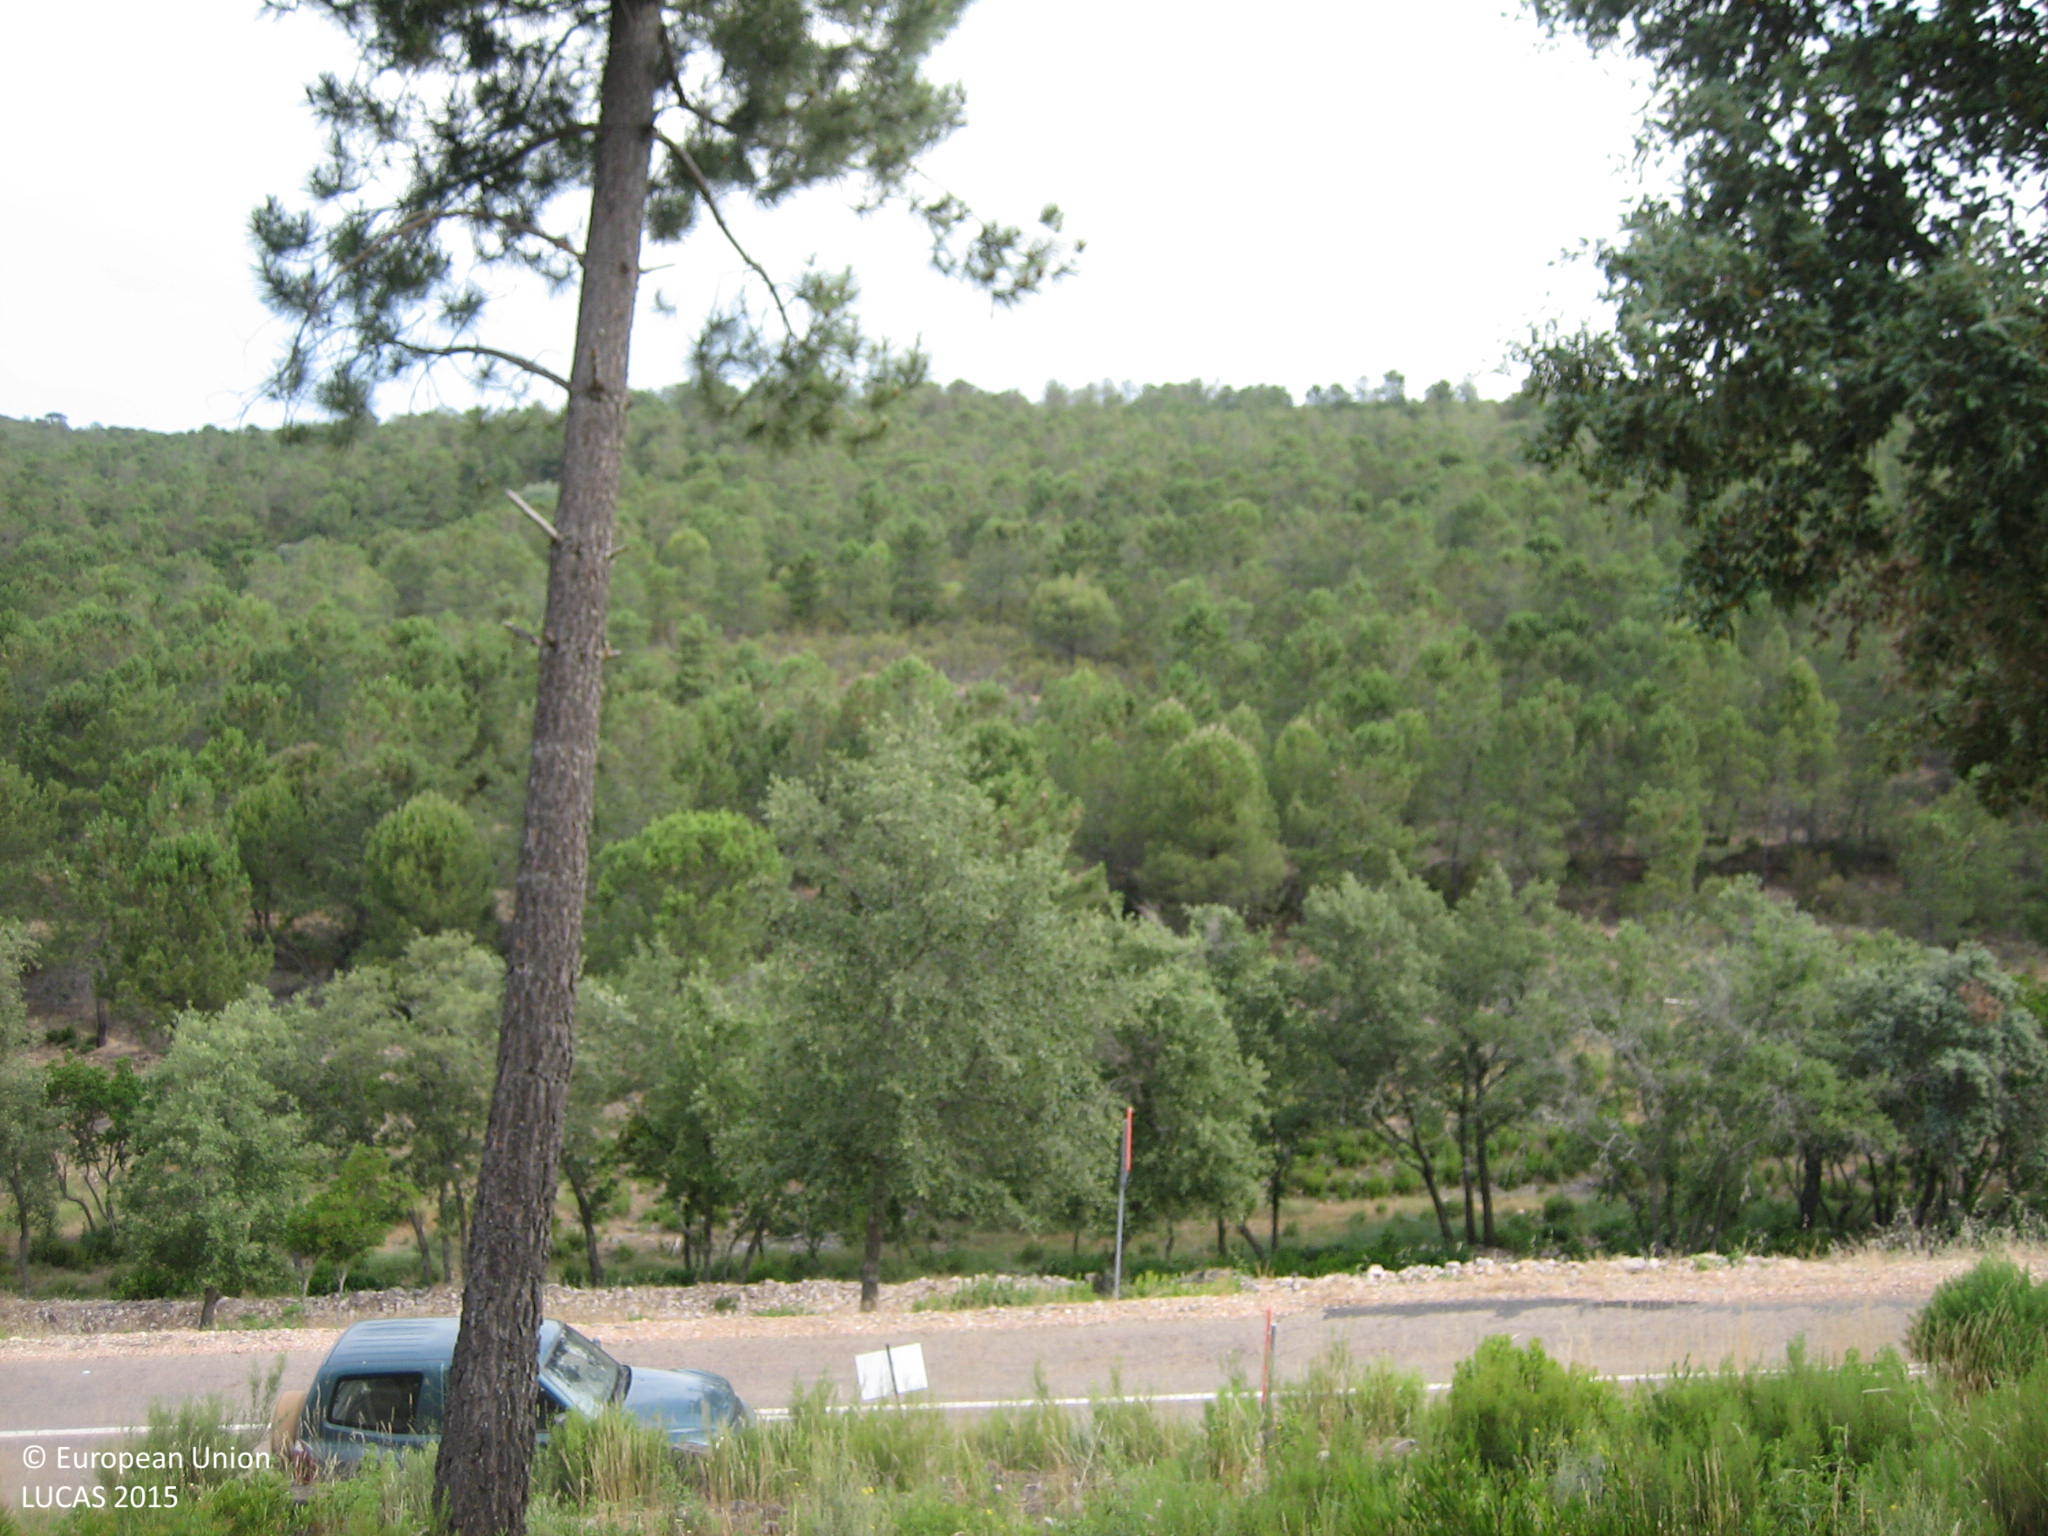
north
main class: Woodland
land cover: Pine dominated coniferous woodland
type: coniferous forest of the mediterranean region
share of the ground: 25 - 50 %
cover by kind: herbaceous plants 50 %, coniferous forest trees 30 %, shrubs 15 %, broadleaved forest trees 5 %
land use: Forestry
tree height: > 5 m
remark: Fire break
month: June
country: ES
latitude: 39.1182
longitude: -4.5695
